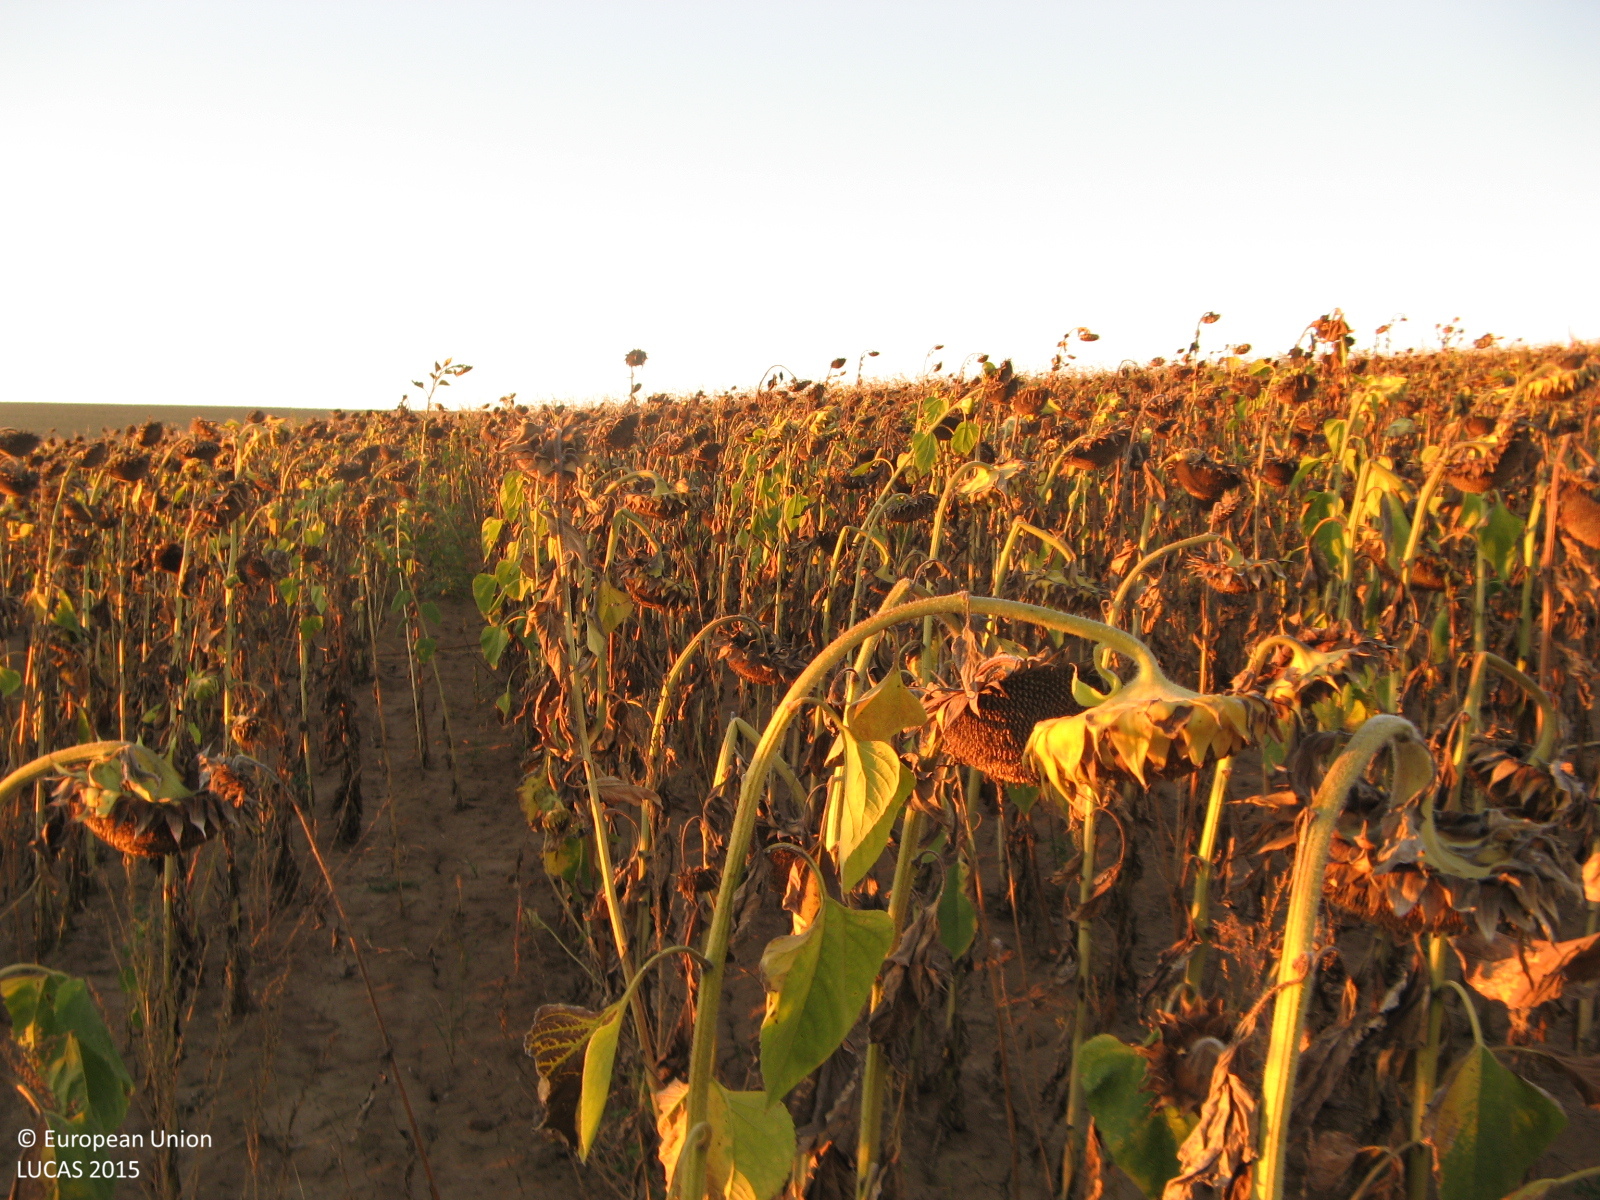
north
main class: Cropland
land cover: Sunflower
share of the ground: > 75 %
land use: Agriculture (excluding fallow land and kitchen gardens)
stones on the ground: < 10 %
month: September
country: BG
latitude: 43.5681
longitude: 26.0543
